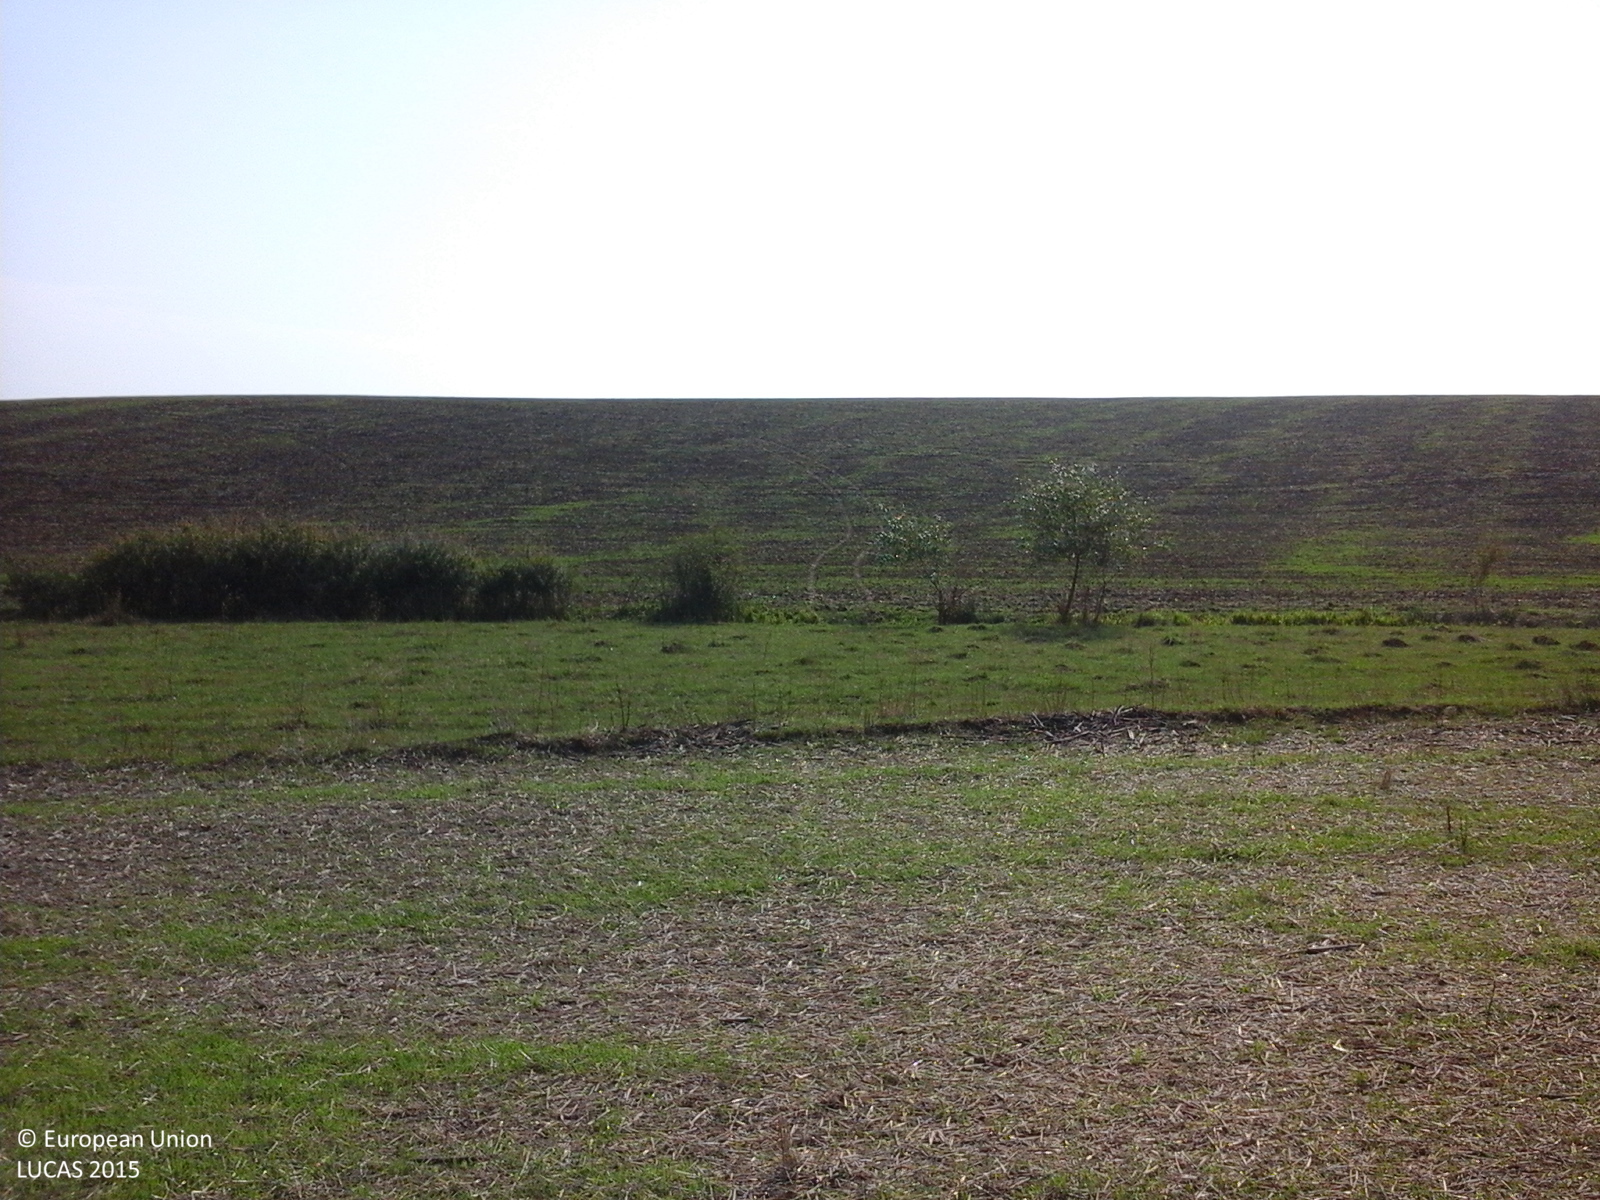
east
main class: Cropland
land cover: Common wheat
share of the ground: 50 - 75 %
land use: Agriculture (excluding fallow land and kitchen gardens)
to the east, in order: Common wheat; Grassland without tree/shrub cover; Abandoned hedges; Ditches and canals; Grass margins; Common wheat
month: August
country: RO
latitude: 46.0916
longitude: 21.5080
